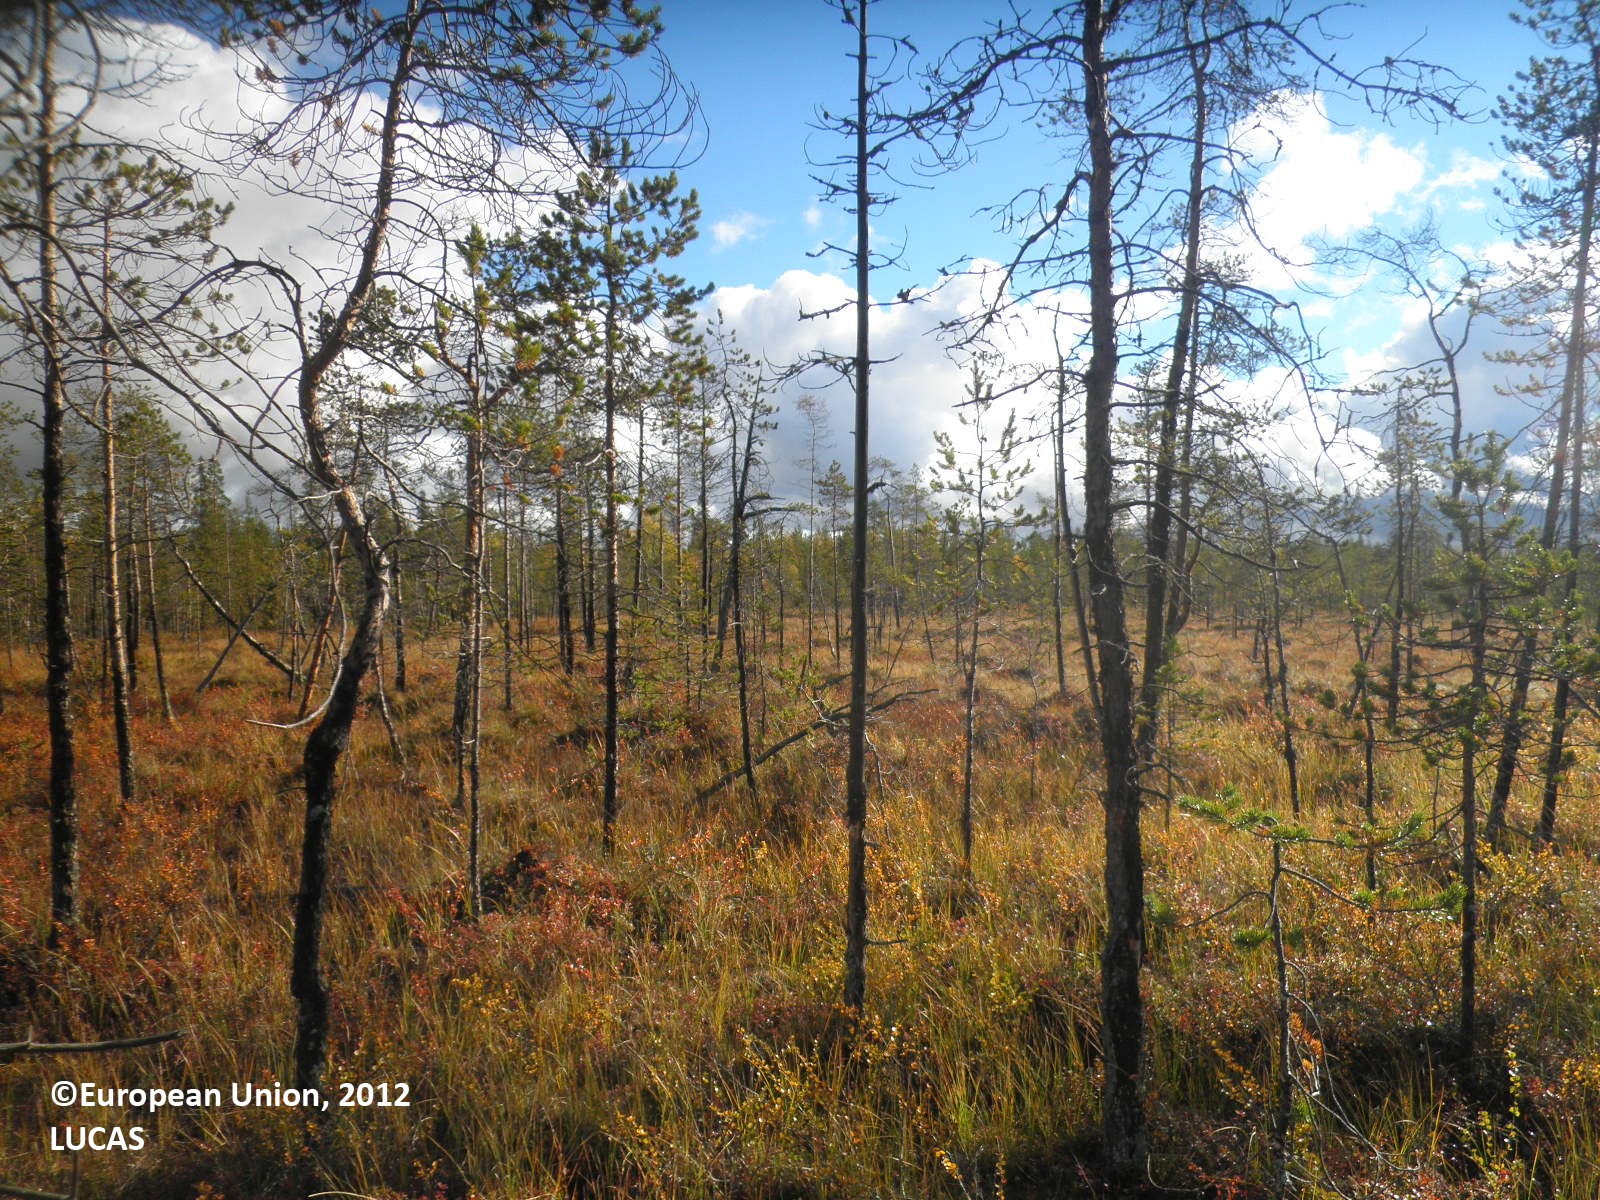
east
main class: Woodland
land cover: Pine dominated coniferous woodland
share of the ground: 10 - 25 %
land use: Forestry
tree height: > 5 m
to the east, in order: Pine dominated coniferous woodland; Peatbogs; Pine dominated mixed woodland; Ditches and canals; Pine dominated mixed woodland
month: September
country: FI
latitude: 67.4527
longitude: 28.4738
